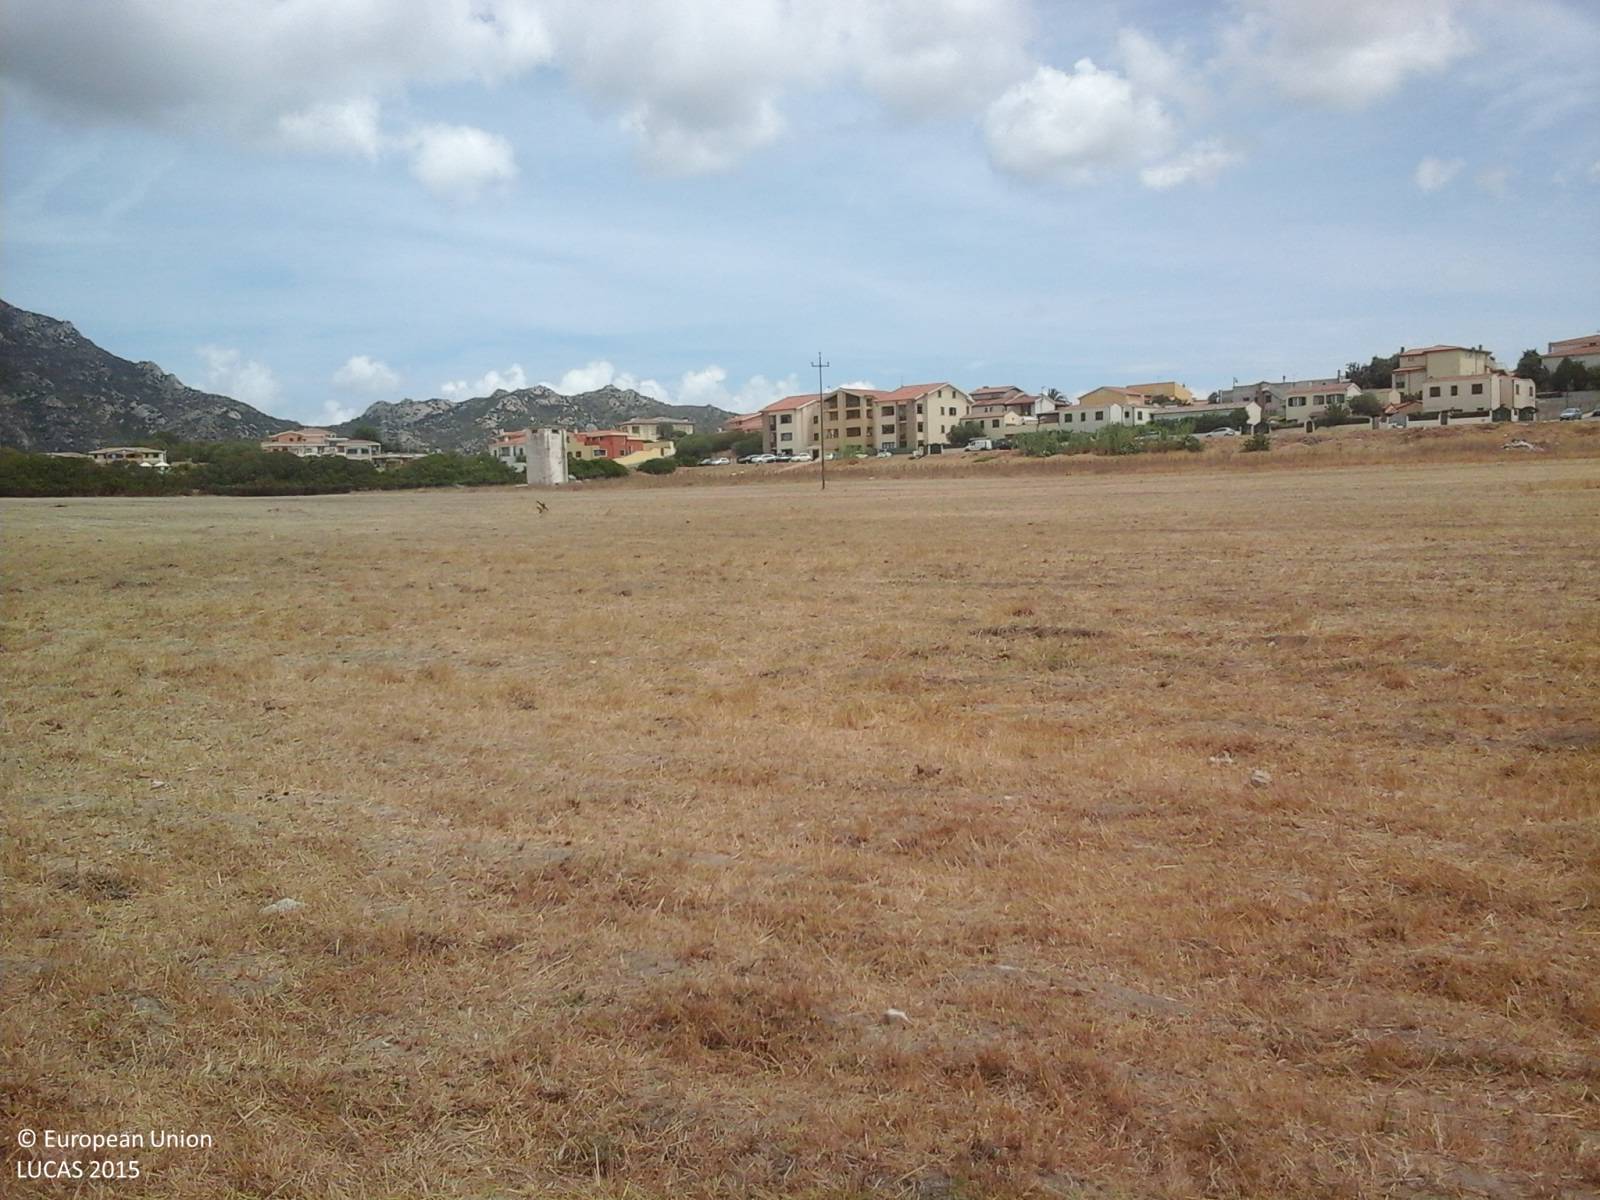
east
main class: Grassland
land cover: Grassland without tree/shrub cover
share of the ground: > 75 %
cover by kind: herbaceous plants 95 %, unconsolidated bare surface 5 %
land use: Agriculture (excluding fallow land and kitchen gardens)
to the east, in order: Grassland without tree/shrub cover; Fences; Grassland without tree/shrub cover; Tracks; Grassland without tree/shrub cover
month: August
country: IT
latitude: 40.9537
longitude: 9.4915
